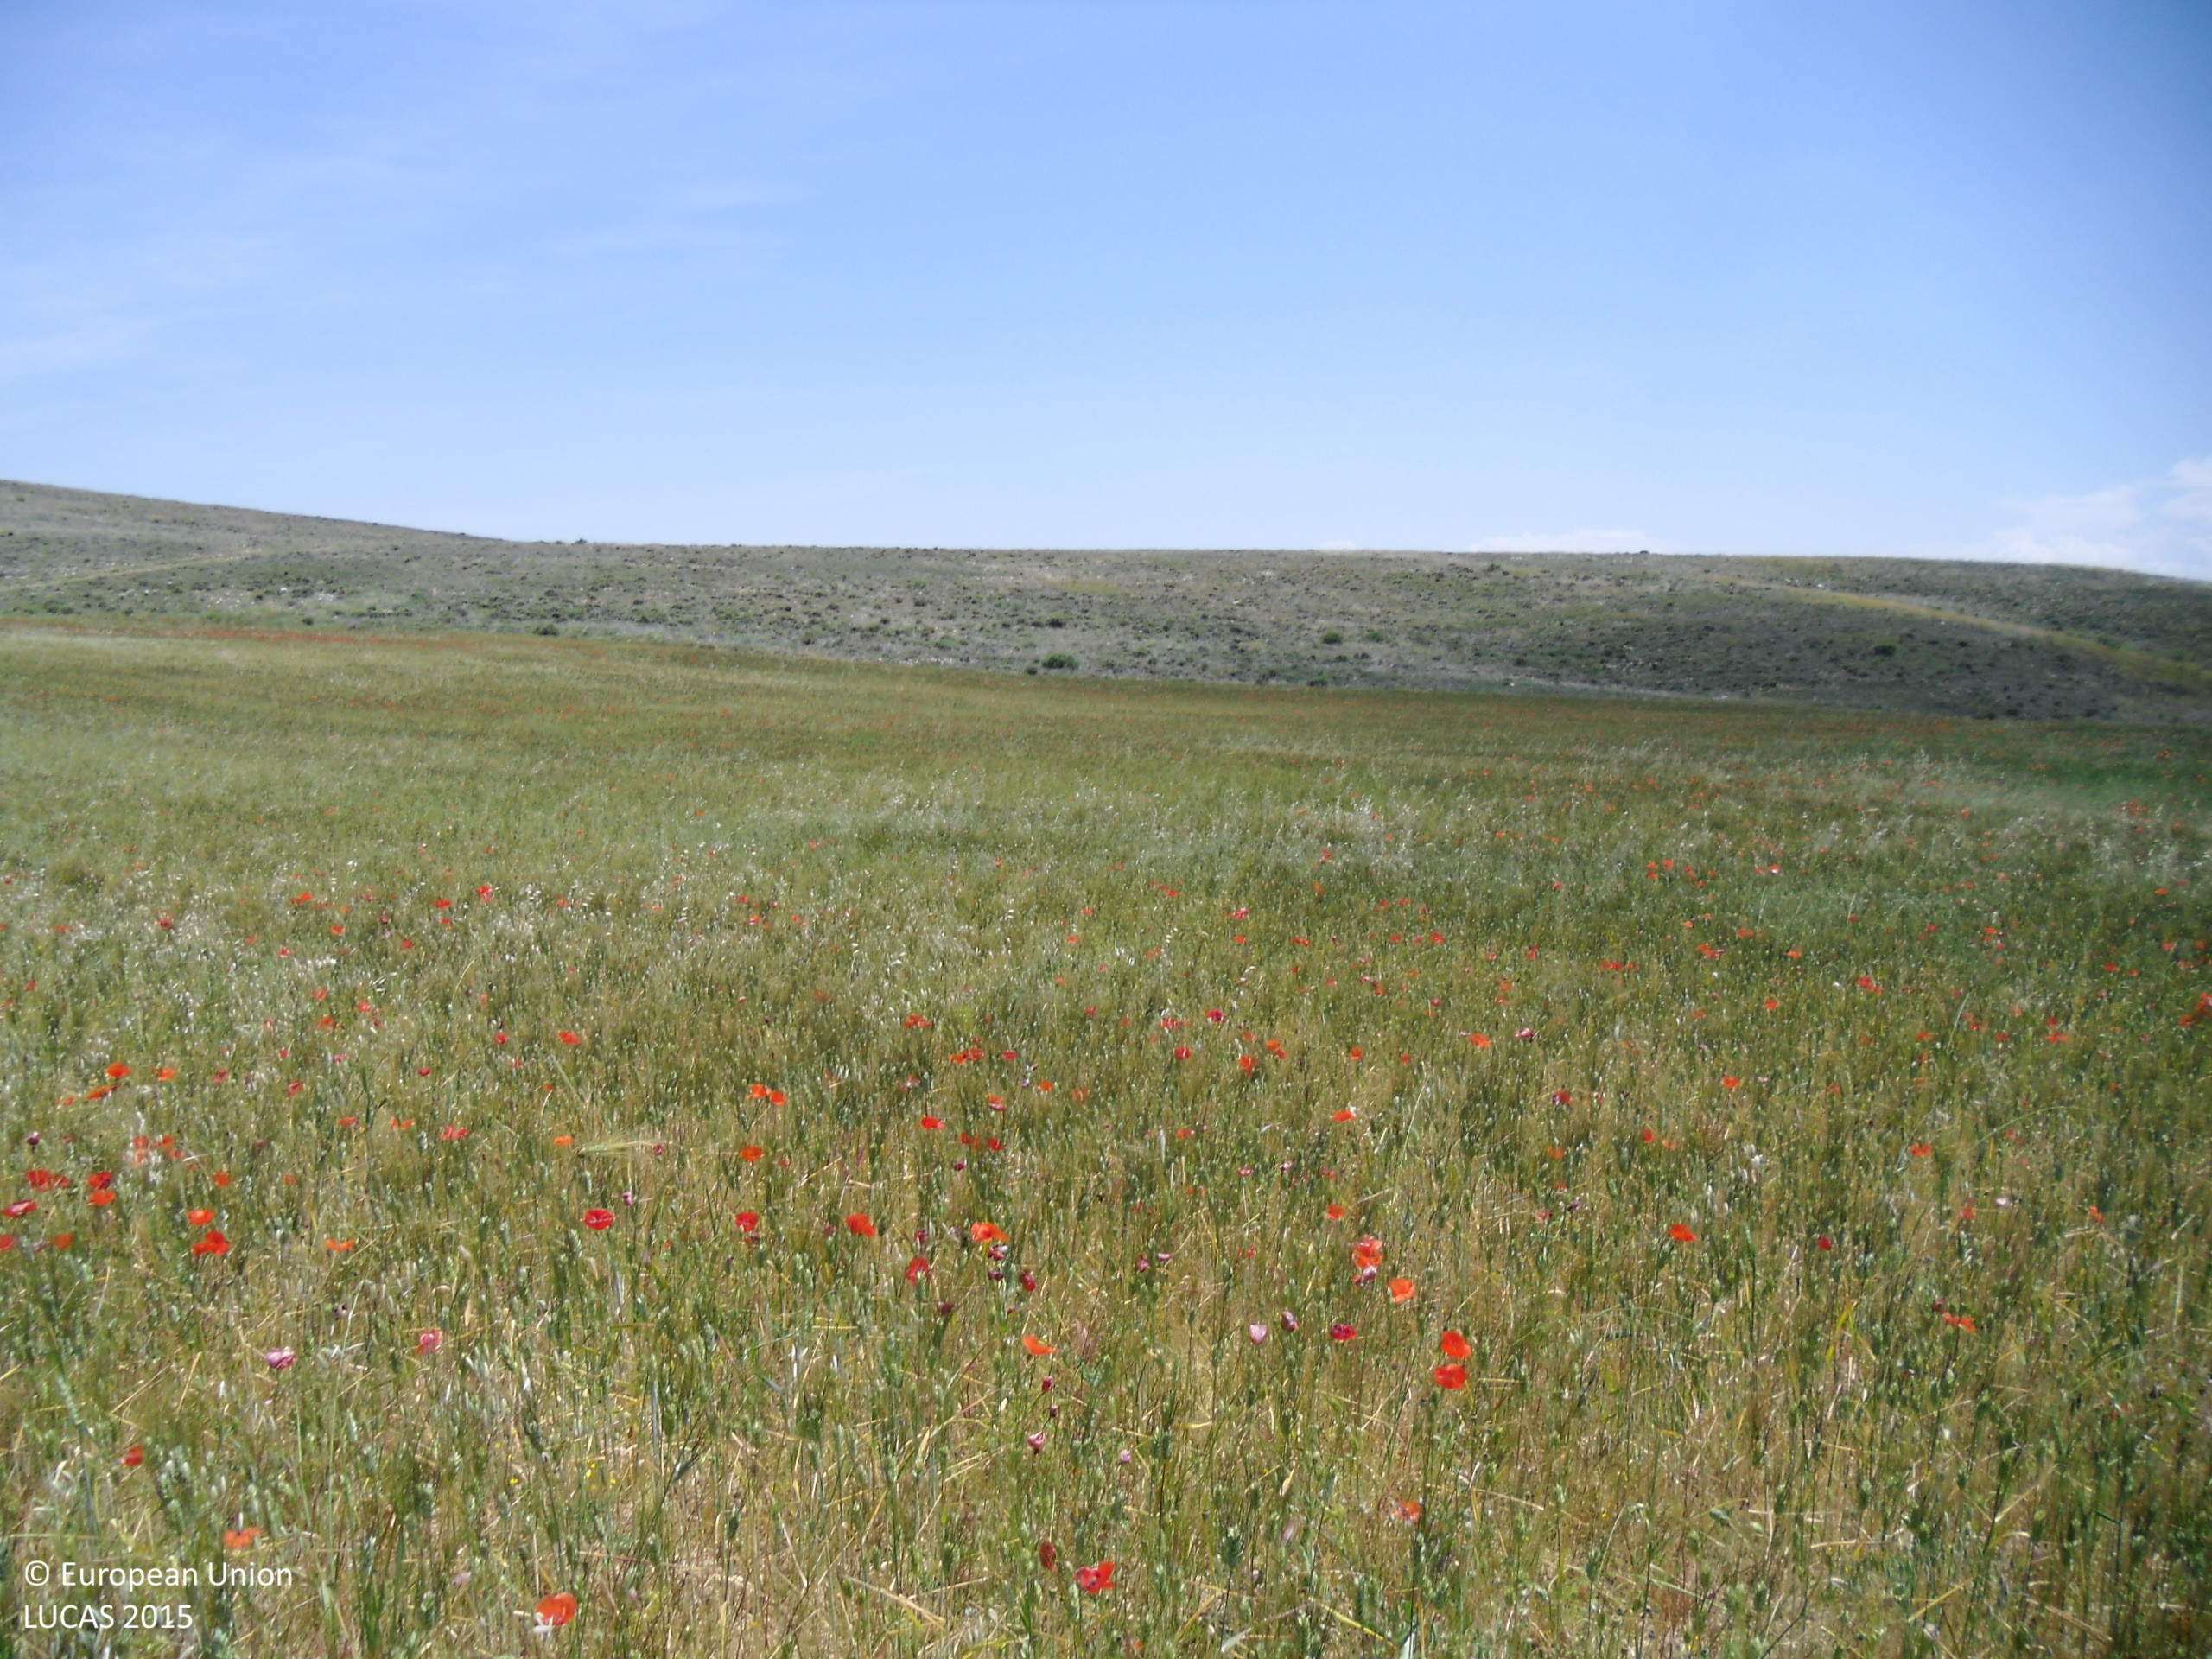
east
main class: Cropland
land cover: Mixed cereals for fodder
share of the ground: > 75 %
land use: Agriculture (excluding fallow land and kitchen gardens)
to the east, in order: Mixed cereals for fodder; Shrubland without tree cover; Tracks; Shrubland without tree cover; Tracks; Shrubland without tree cover
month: June
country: ES
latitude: 41.1000
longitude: -0.8873
